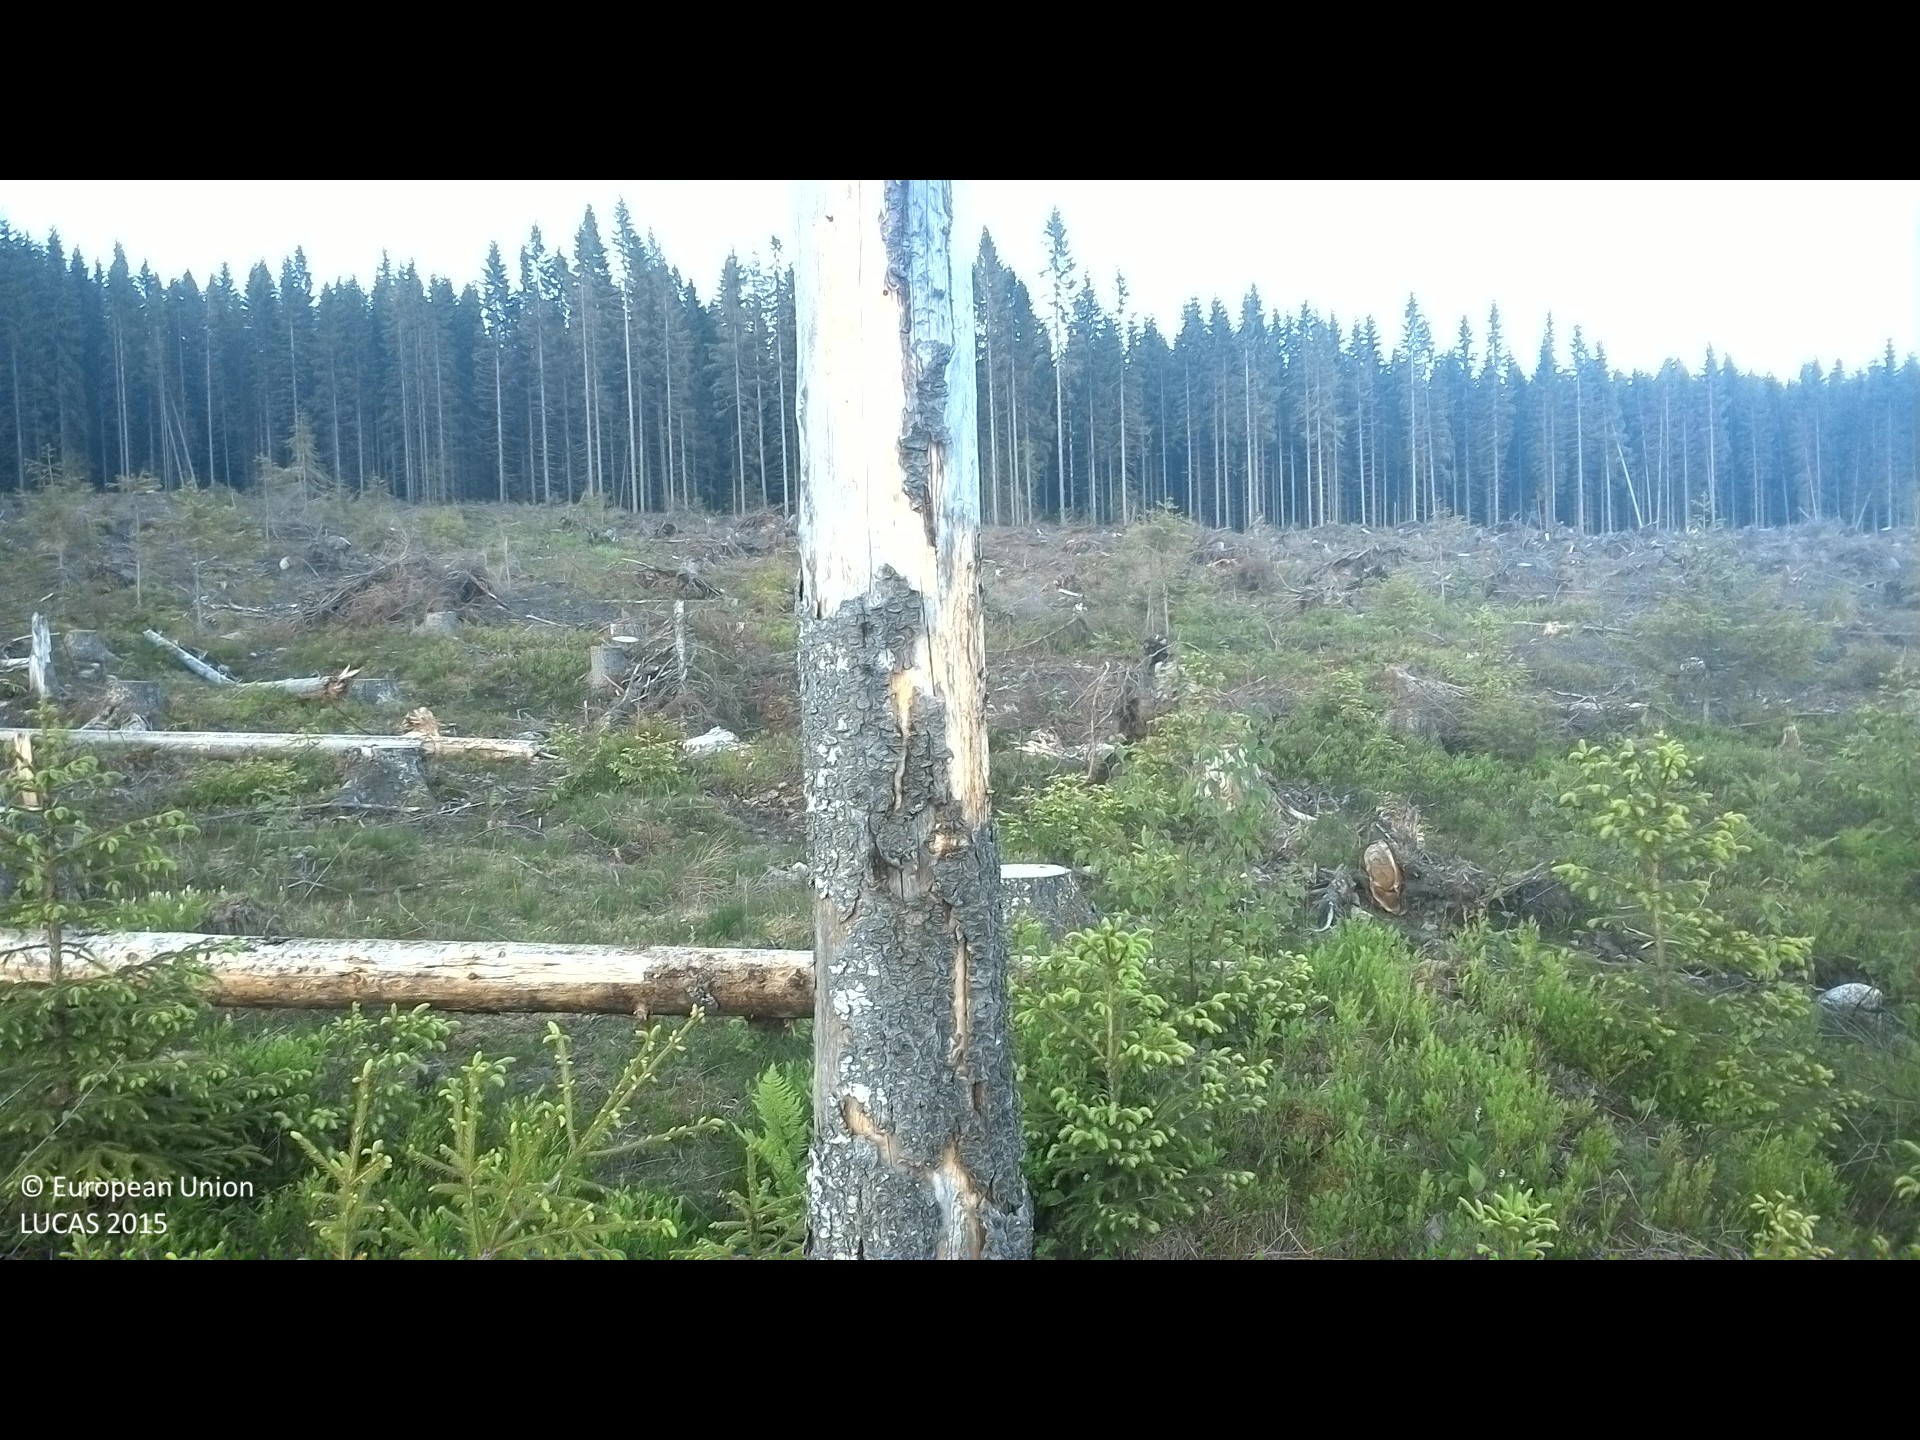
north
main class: Shrubland
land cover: Shrubland with sparse tree cover
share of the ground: 25 - 50 %
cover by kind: unconsolidated bare surface 50 %, shrubs 30 %, herbaceous plants 15 %, coniferous forest trees 5 %
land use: Forestry
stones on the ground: 10 - 25 %
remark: Clear cut
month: June
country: SE
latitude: 62.0114
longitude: 16.6862
